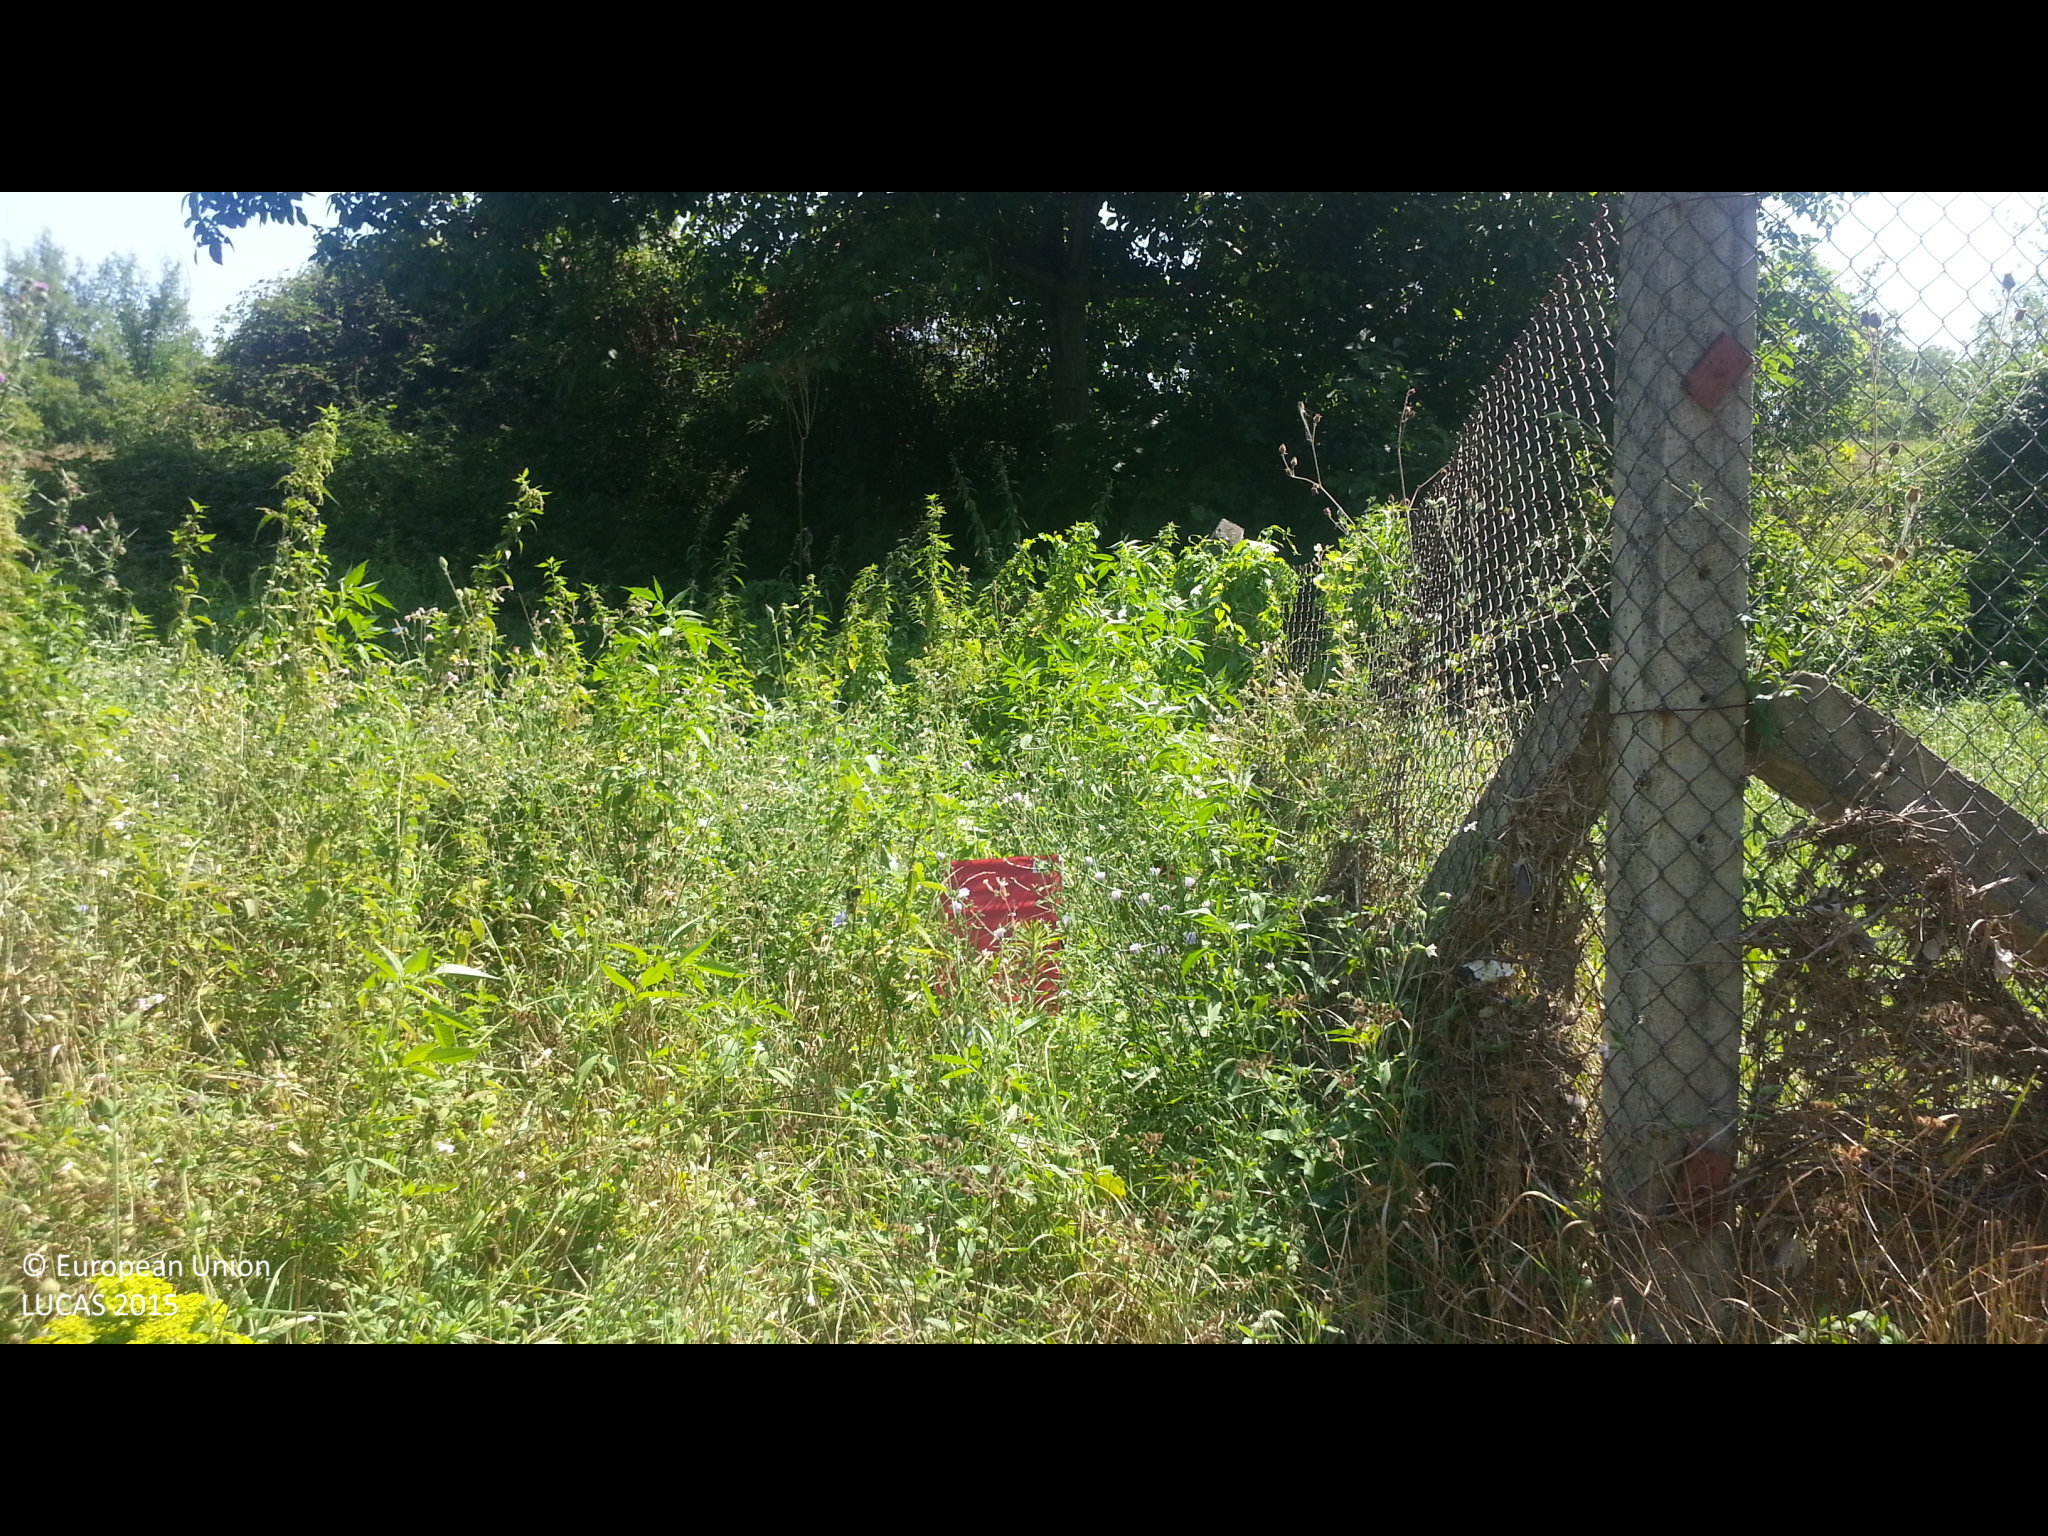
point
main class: Grassland
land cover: Grassland with sparse tree/shrub cover
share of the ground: > 75 %
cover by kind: herbaceous plants 90 %, broadleaved forest trees 5 %, shrubs 5 %
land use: Residential
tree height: > 5 m
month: August
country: BG
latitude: 42.2090
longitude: 22.8992
